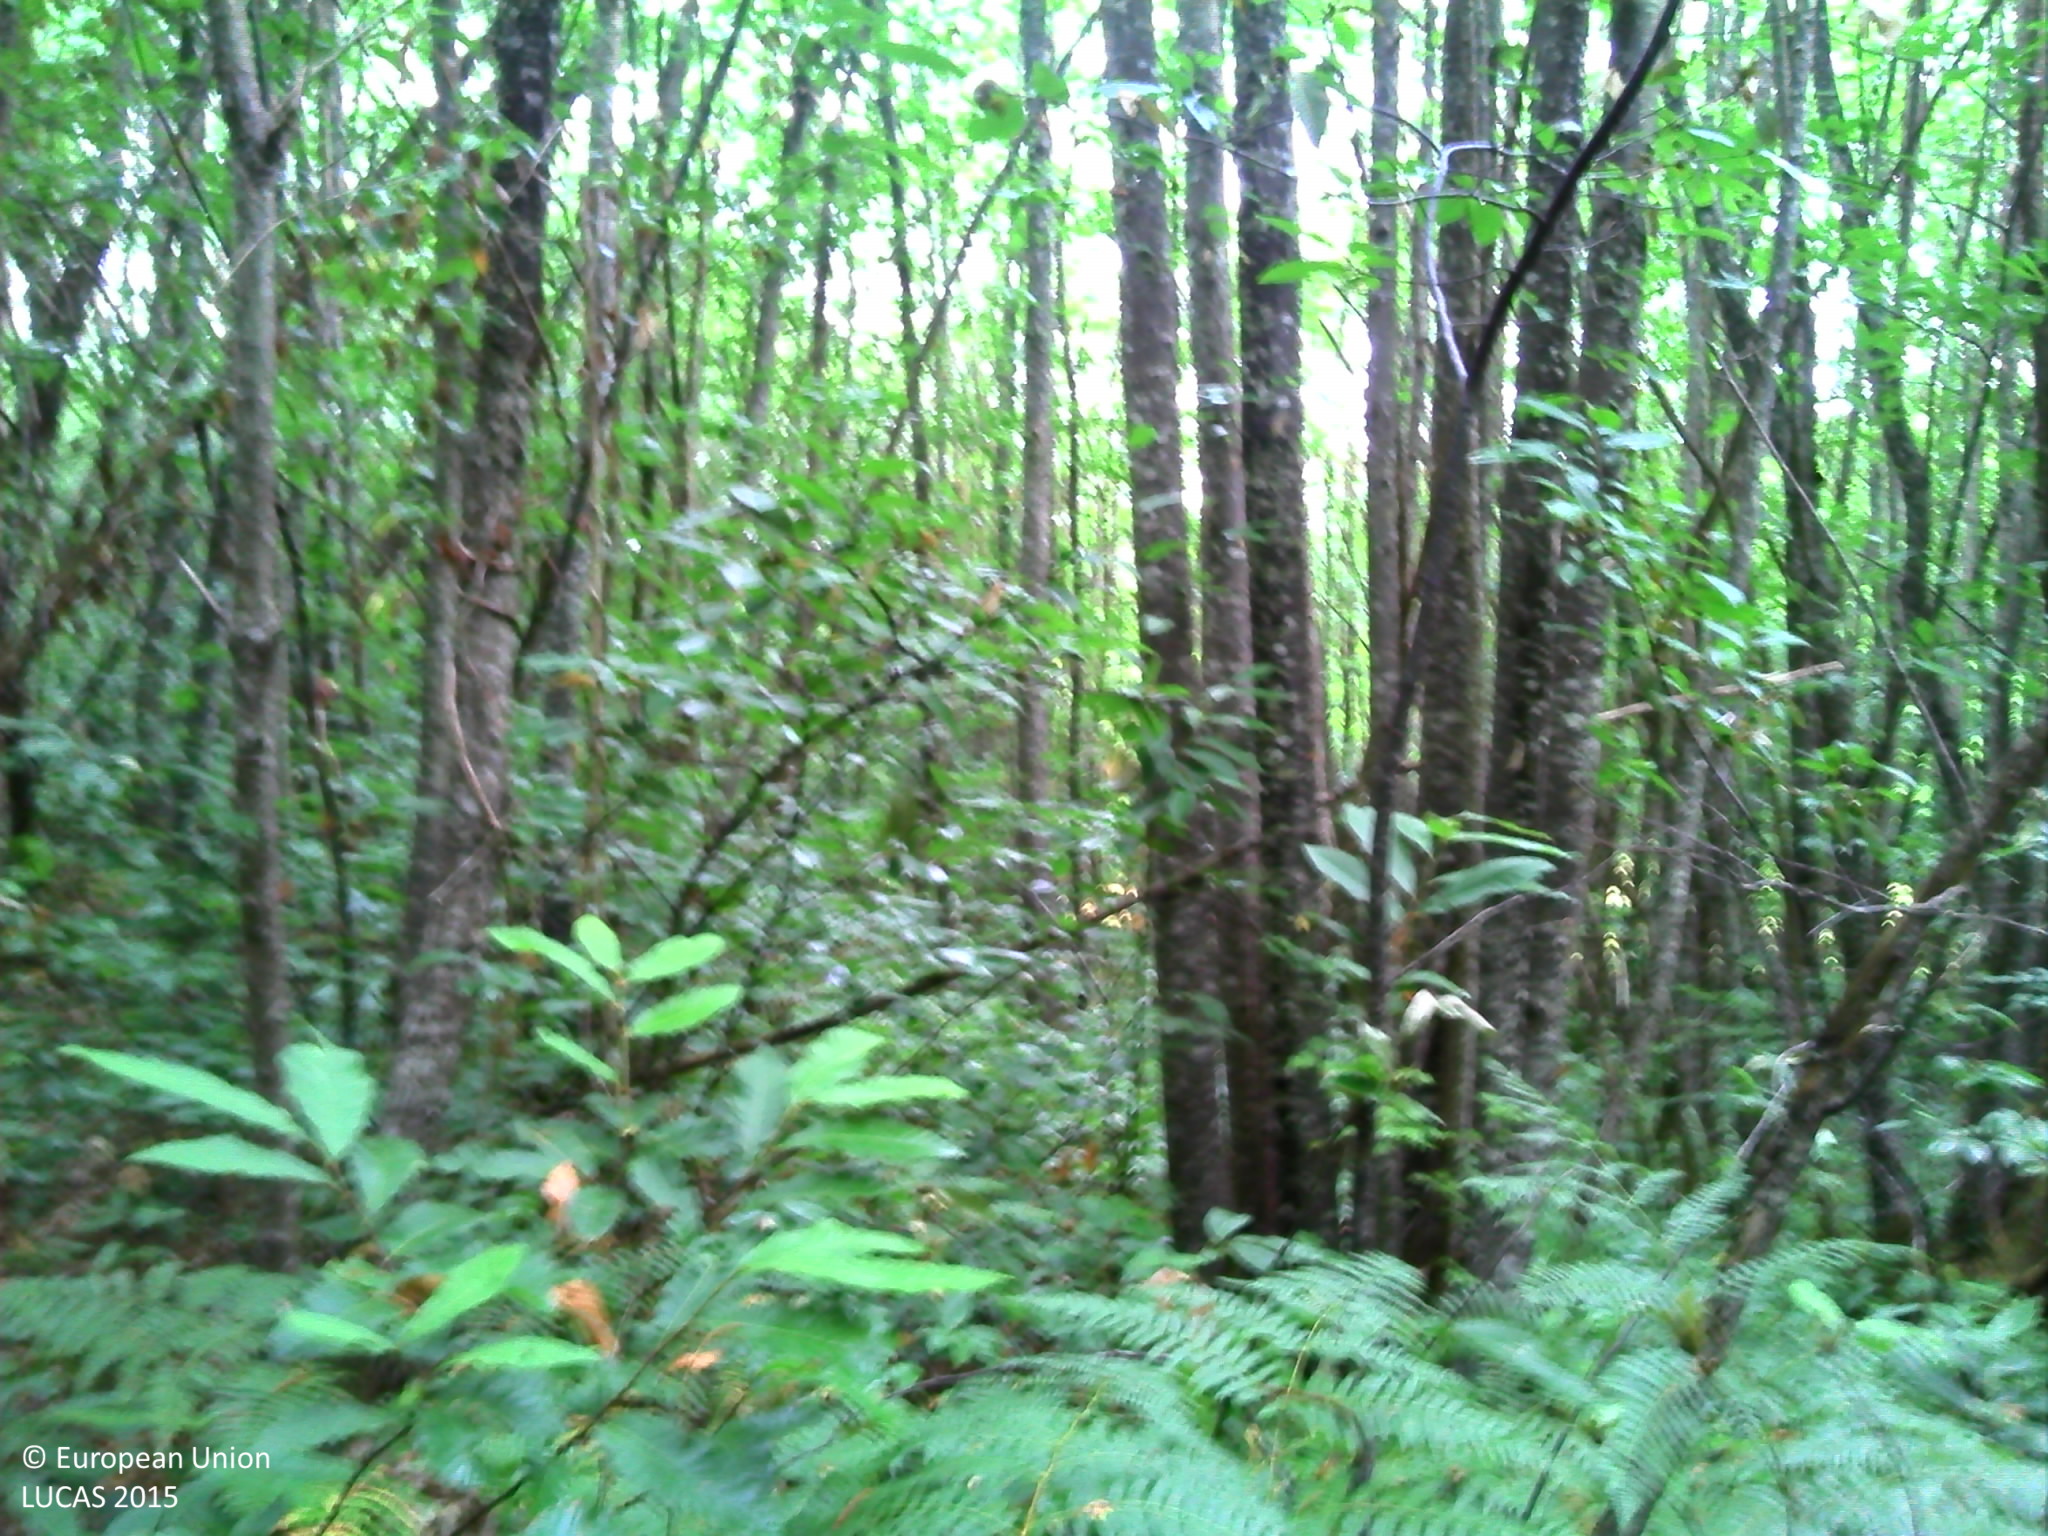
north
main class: Woodland
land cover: Broadleaved woodland
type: thermophilous deciduous forest
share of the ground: > 75 %
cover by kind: broadleaved forest trees 80 %, herbaceous plants 10 %, shrubs 5 %, lichens and mosses 5 %
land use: Forestry
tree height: > 5 m
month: August
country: FR
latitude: 44.6553
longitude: 0.8765
